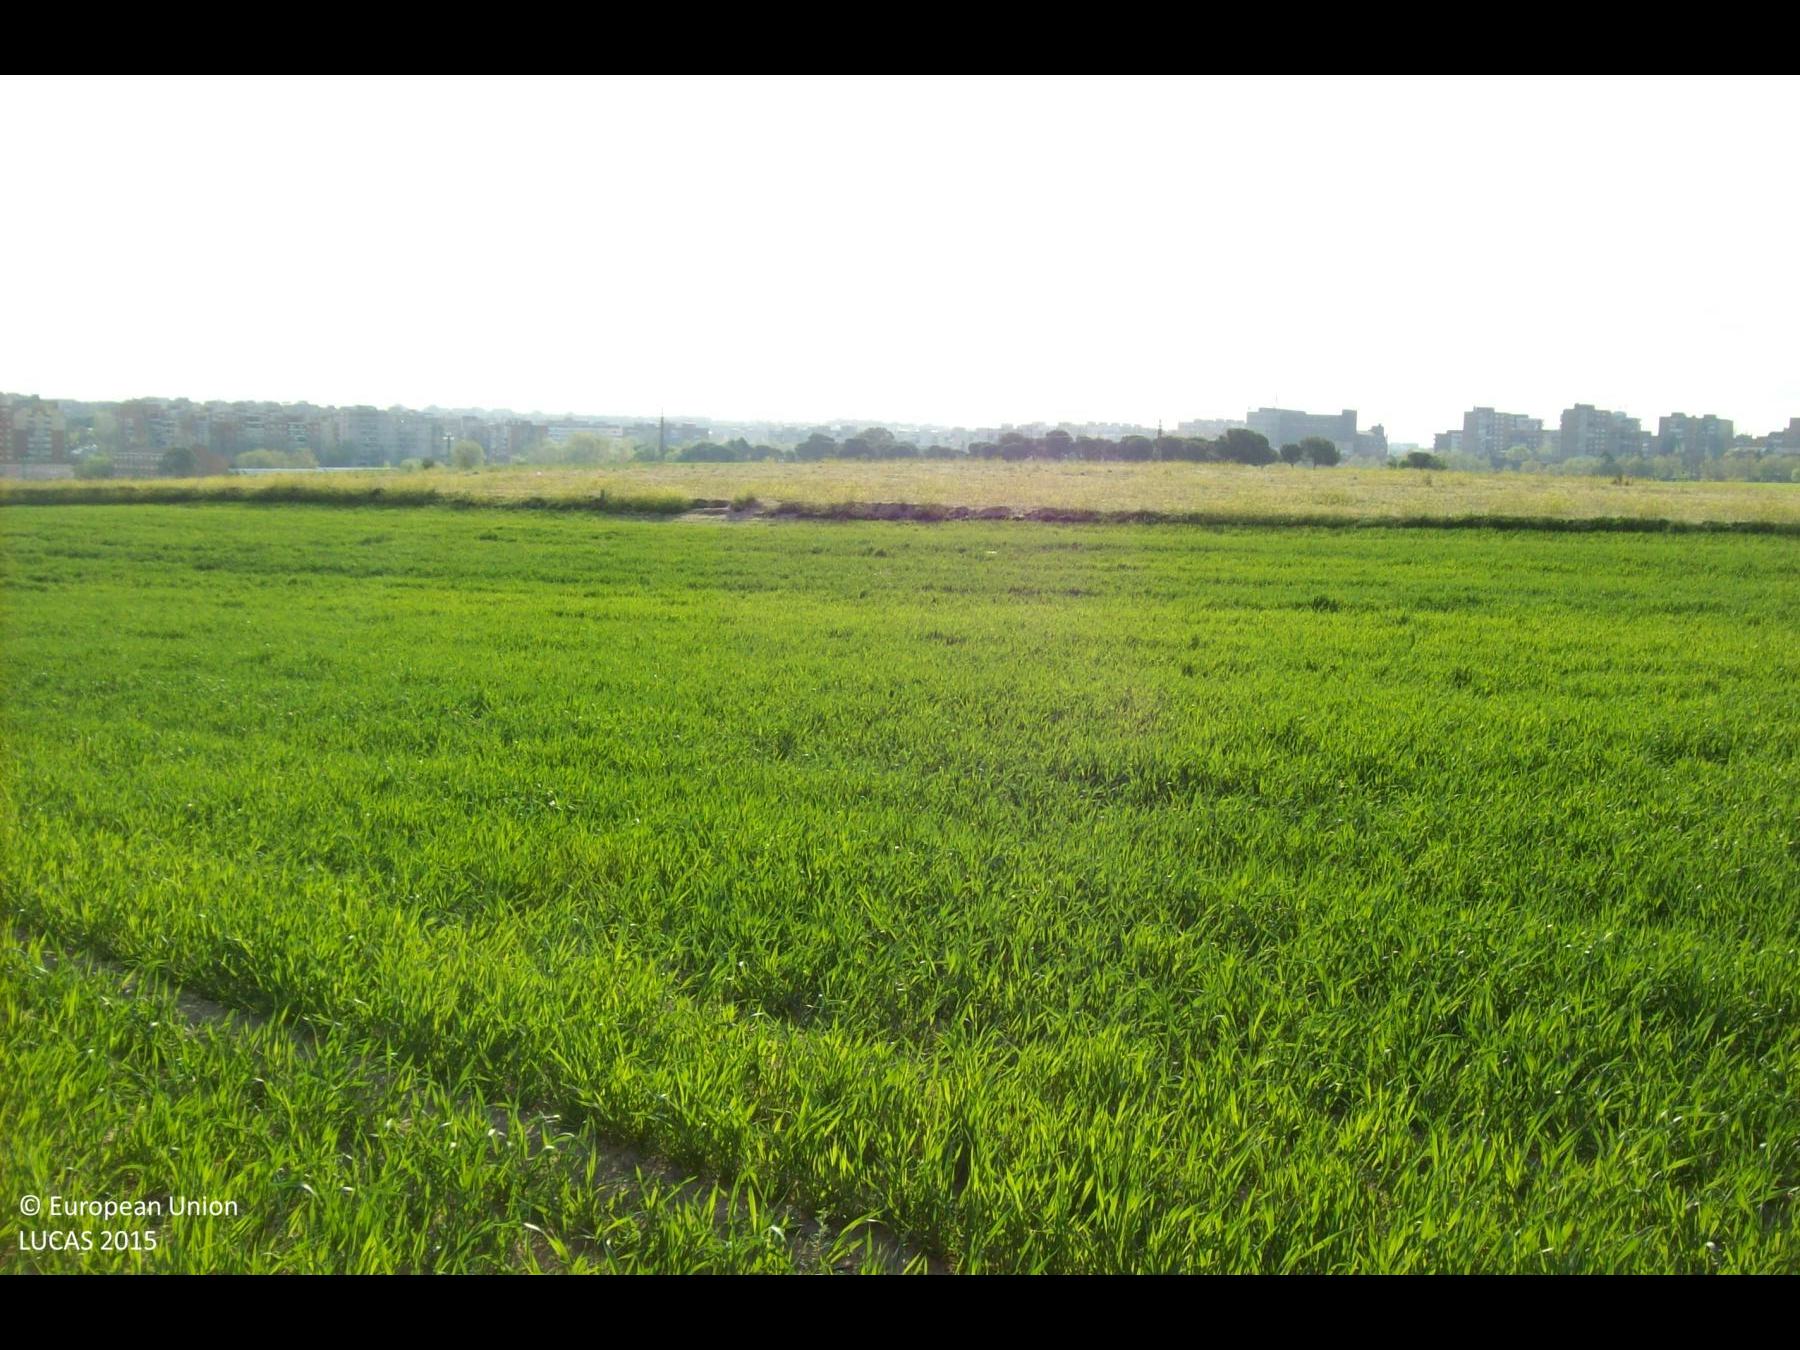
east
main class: Cropland
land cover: Barley
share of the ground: > 75 %
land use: Agriculture (excluding fallow land and kitchen gardens)
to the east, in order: Barley; Grass margins; Spontaneously vegetated surfaces; Shrubland without tree cover; Spontaneously vegetated surfaces
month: April
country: ES
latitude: 40.3186
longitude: -3.8899
